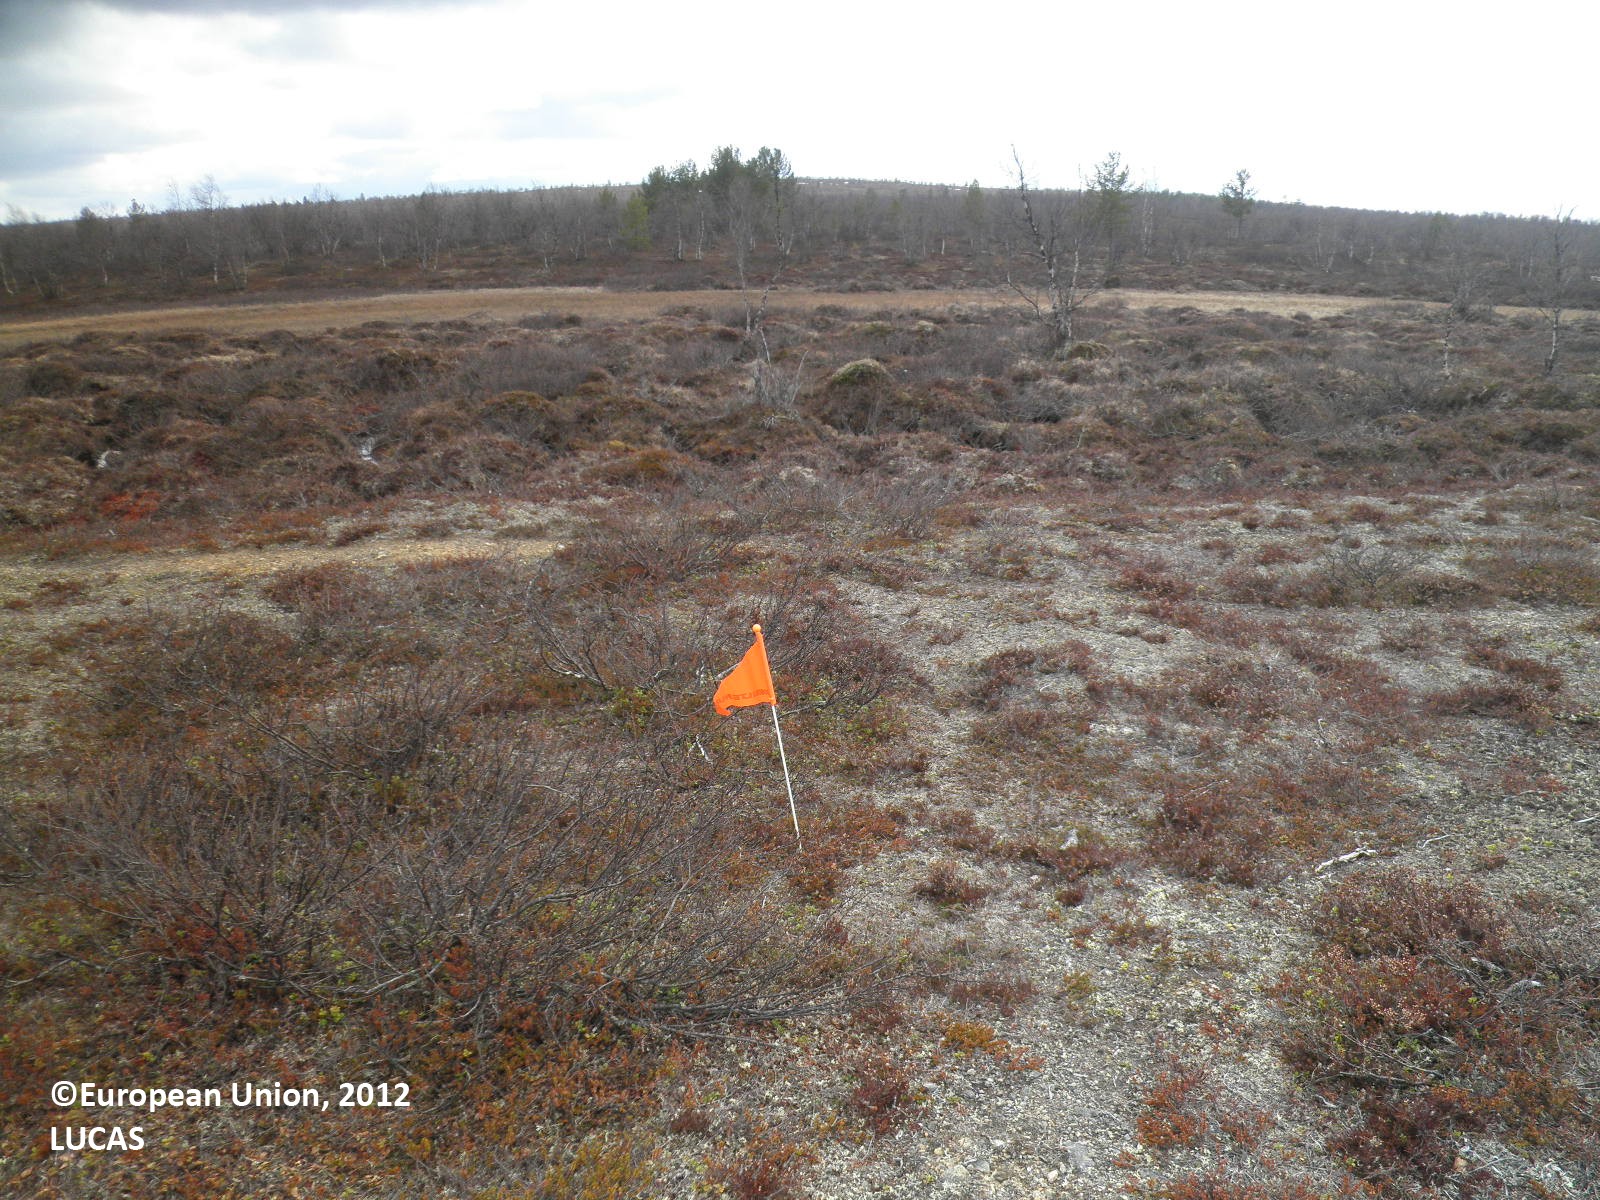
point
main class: Shrubland
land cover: Shrubland with sparse tree cover
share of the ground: 25 - 50 %
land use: Forestry
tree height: < 5 m
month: May
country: FI
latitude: 69.3220
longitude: 26.6124
